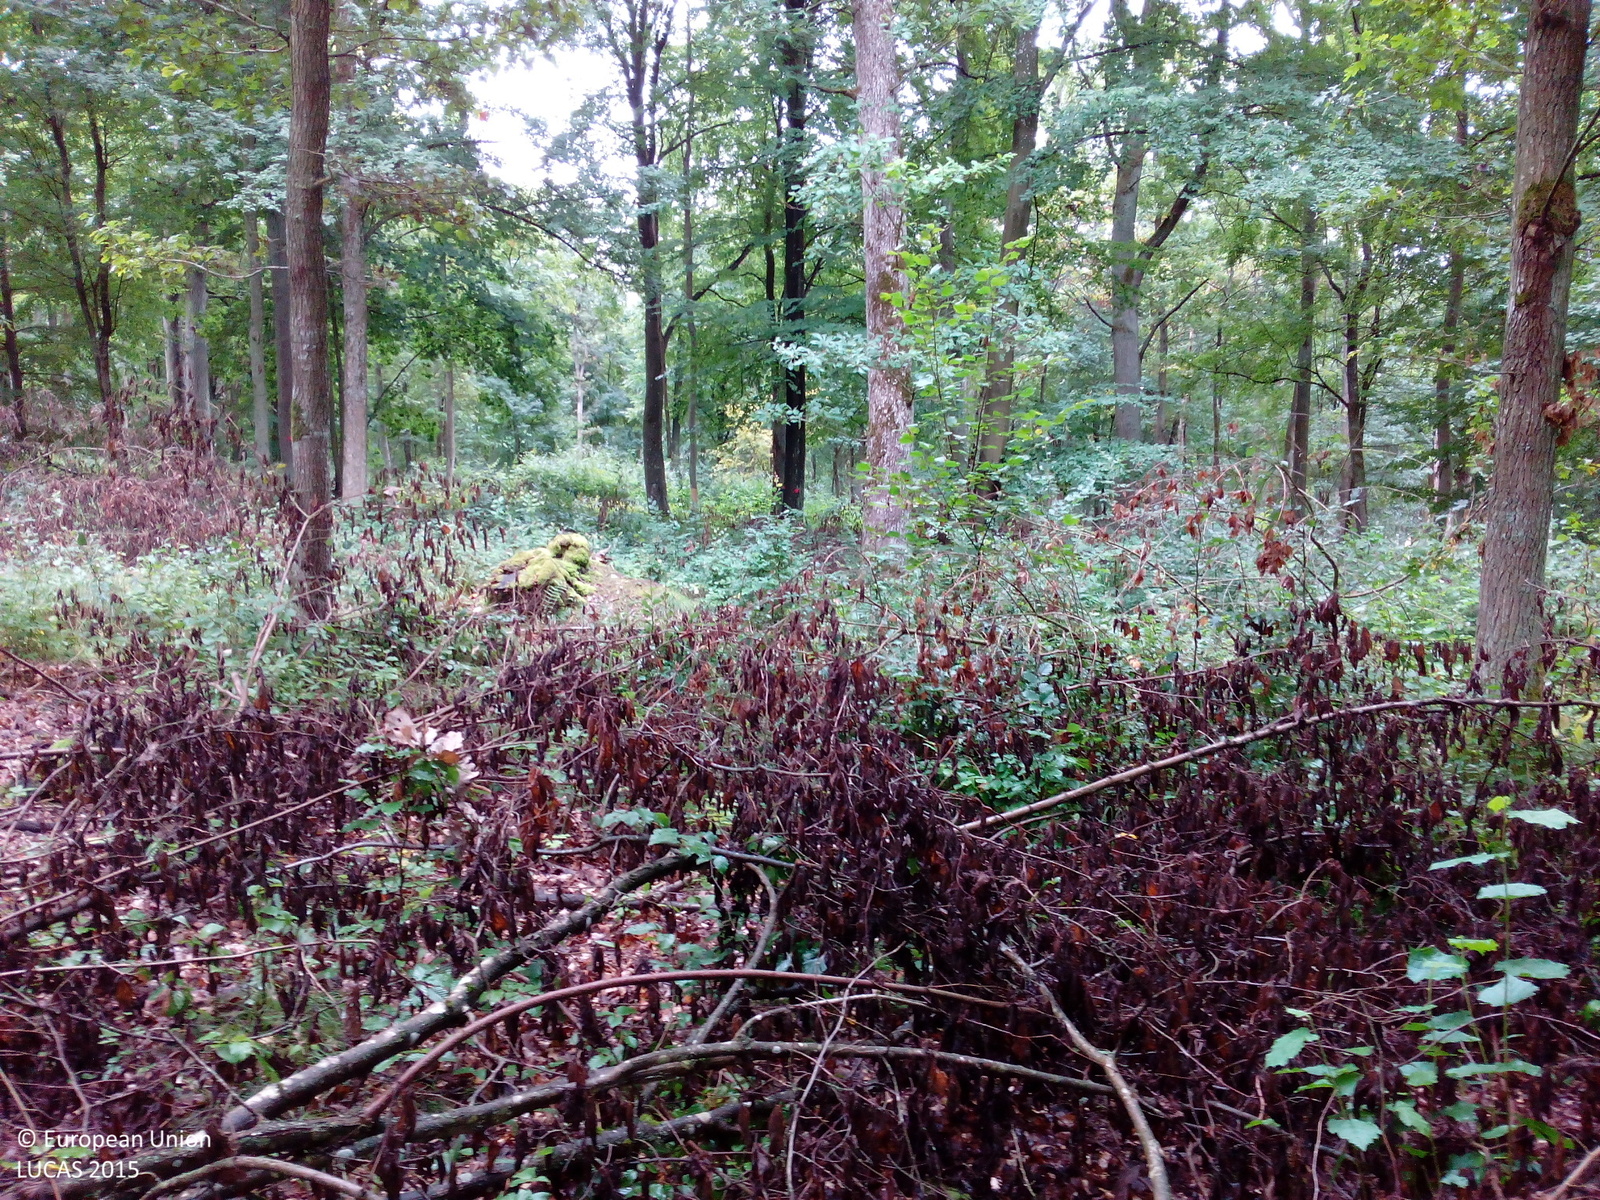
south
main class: Woodland
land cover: Broadleaved woodland
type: mesophytic deciduous forest
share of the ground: > 75 %
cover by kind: broadleaved forest trees 90 %, herbaceous plants 5 %, unconsolidated bare surface 5 %
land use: Forestry
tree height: > 5 m
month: September
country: DE
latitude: 50.0763
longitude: 9.9581
